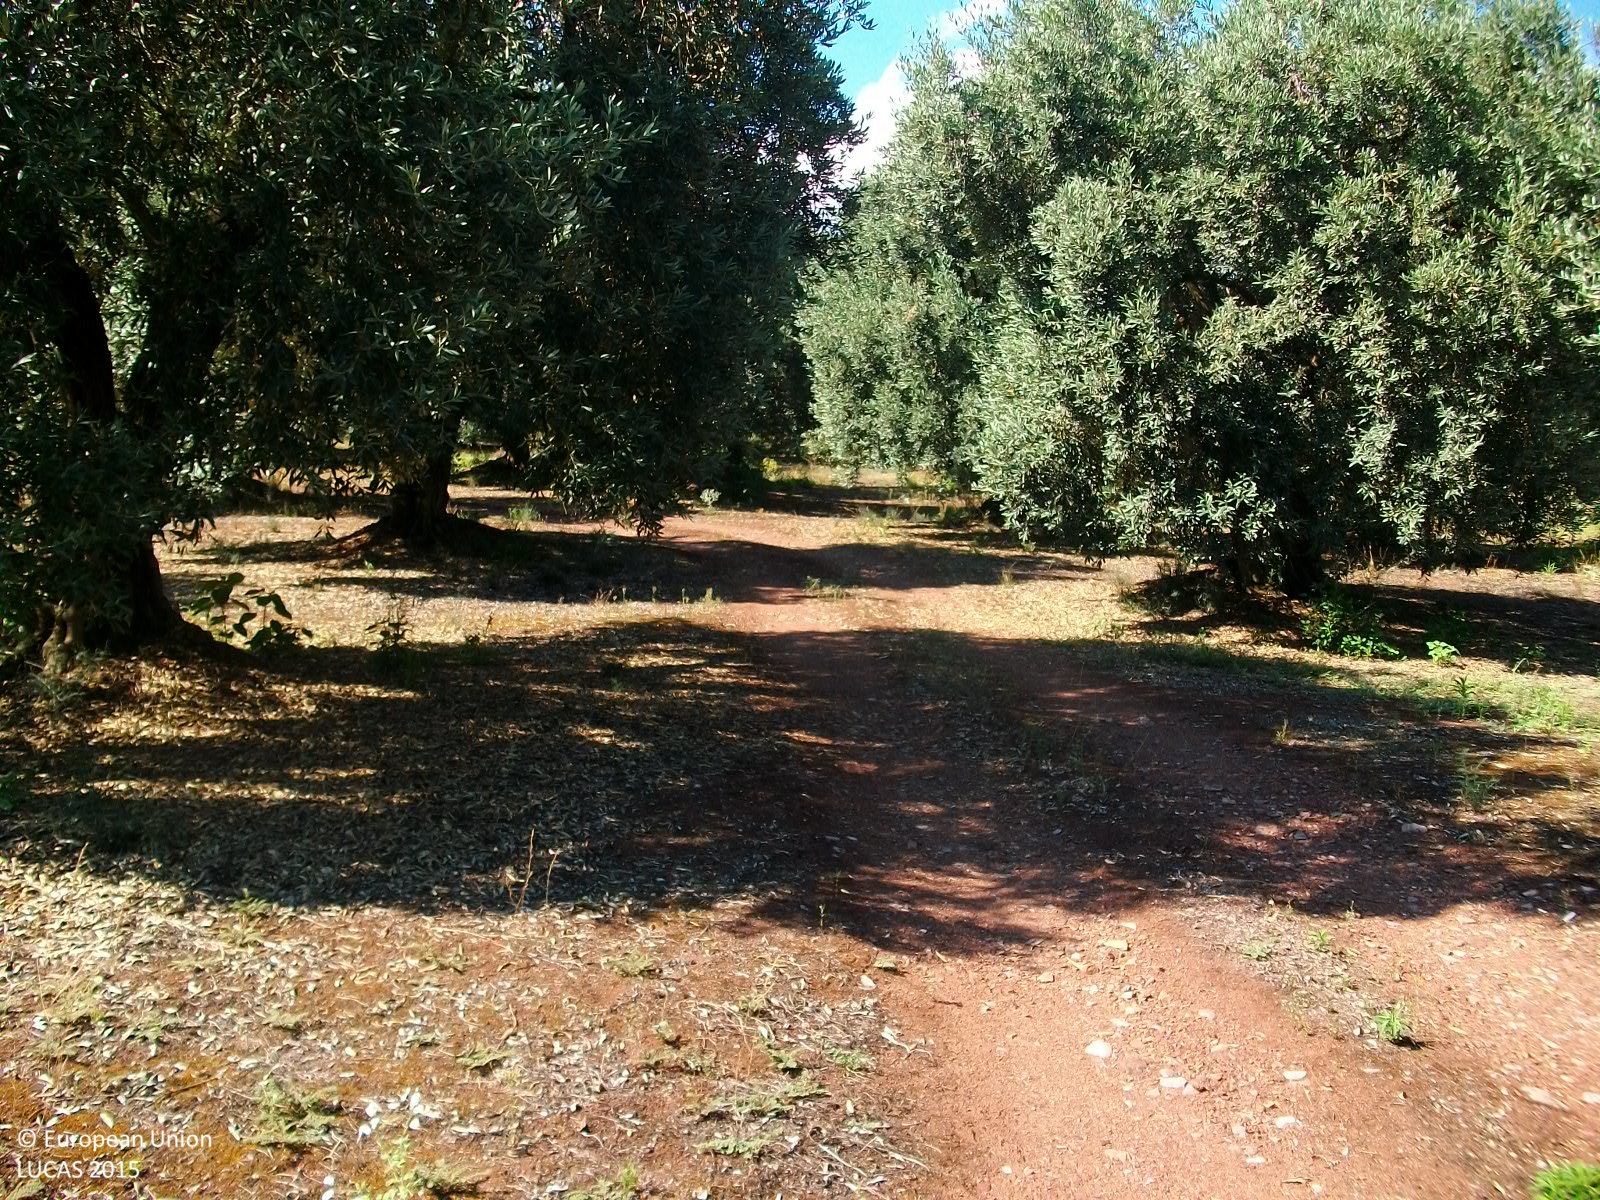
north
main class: Cropland
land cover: Olive groves
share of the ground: > 75 %
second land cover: Spontaneously vegetated surfaces
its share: 25 - 50 %
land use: Agriculture (excluding fallow land and kitchen gardens)
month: June
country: GR
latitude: 38.9163
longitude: 22.6345
